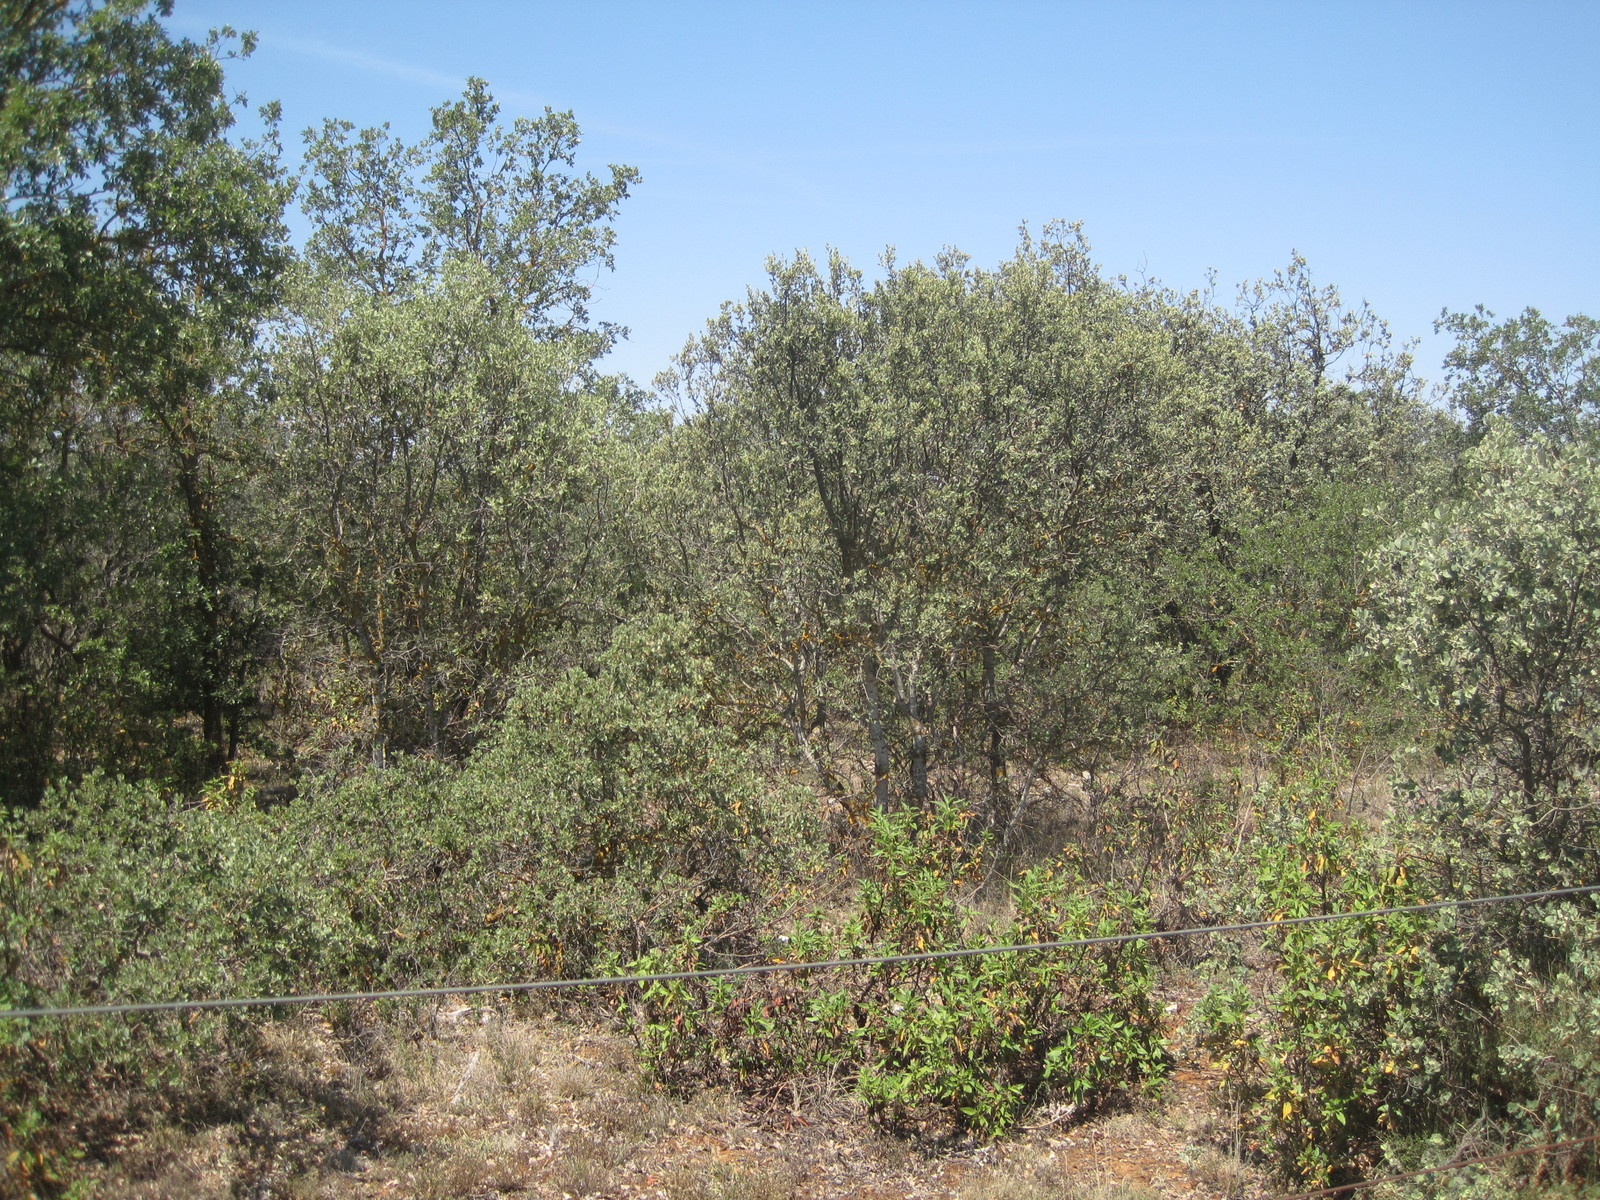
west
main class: Woodland
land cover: Broadleaved woodland
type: broadleaved evergreen forest
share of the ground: 50 - 75 %
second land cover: Grassland without tree/shrub cover
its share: 50 - 75 %
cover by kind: broadleaved forest trees 70 %, herbaceous plants 30 %
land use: Forestry
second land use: Agriculture (excluding fallow land and kitchen gardens)
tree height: > 5 m
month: July
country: ES
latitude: 41.7672
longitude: -5.1262
